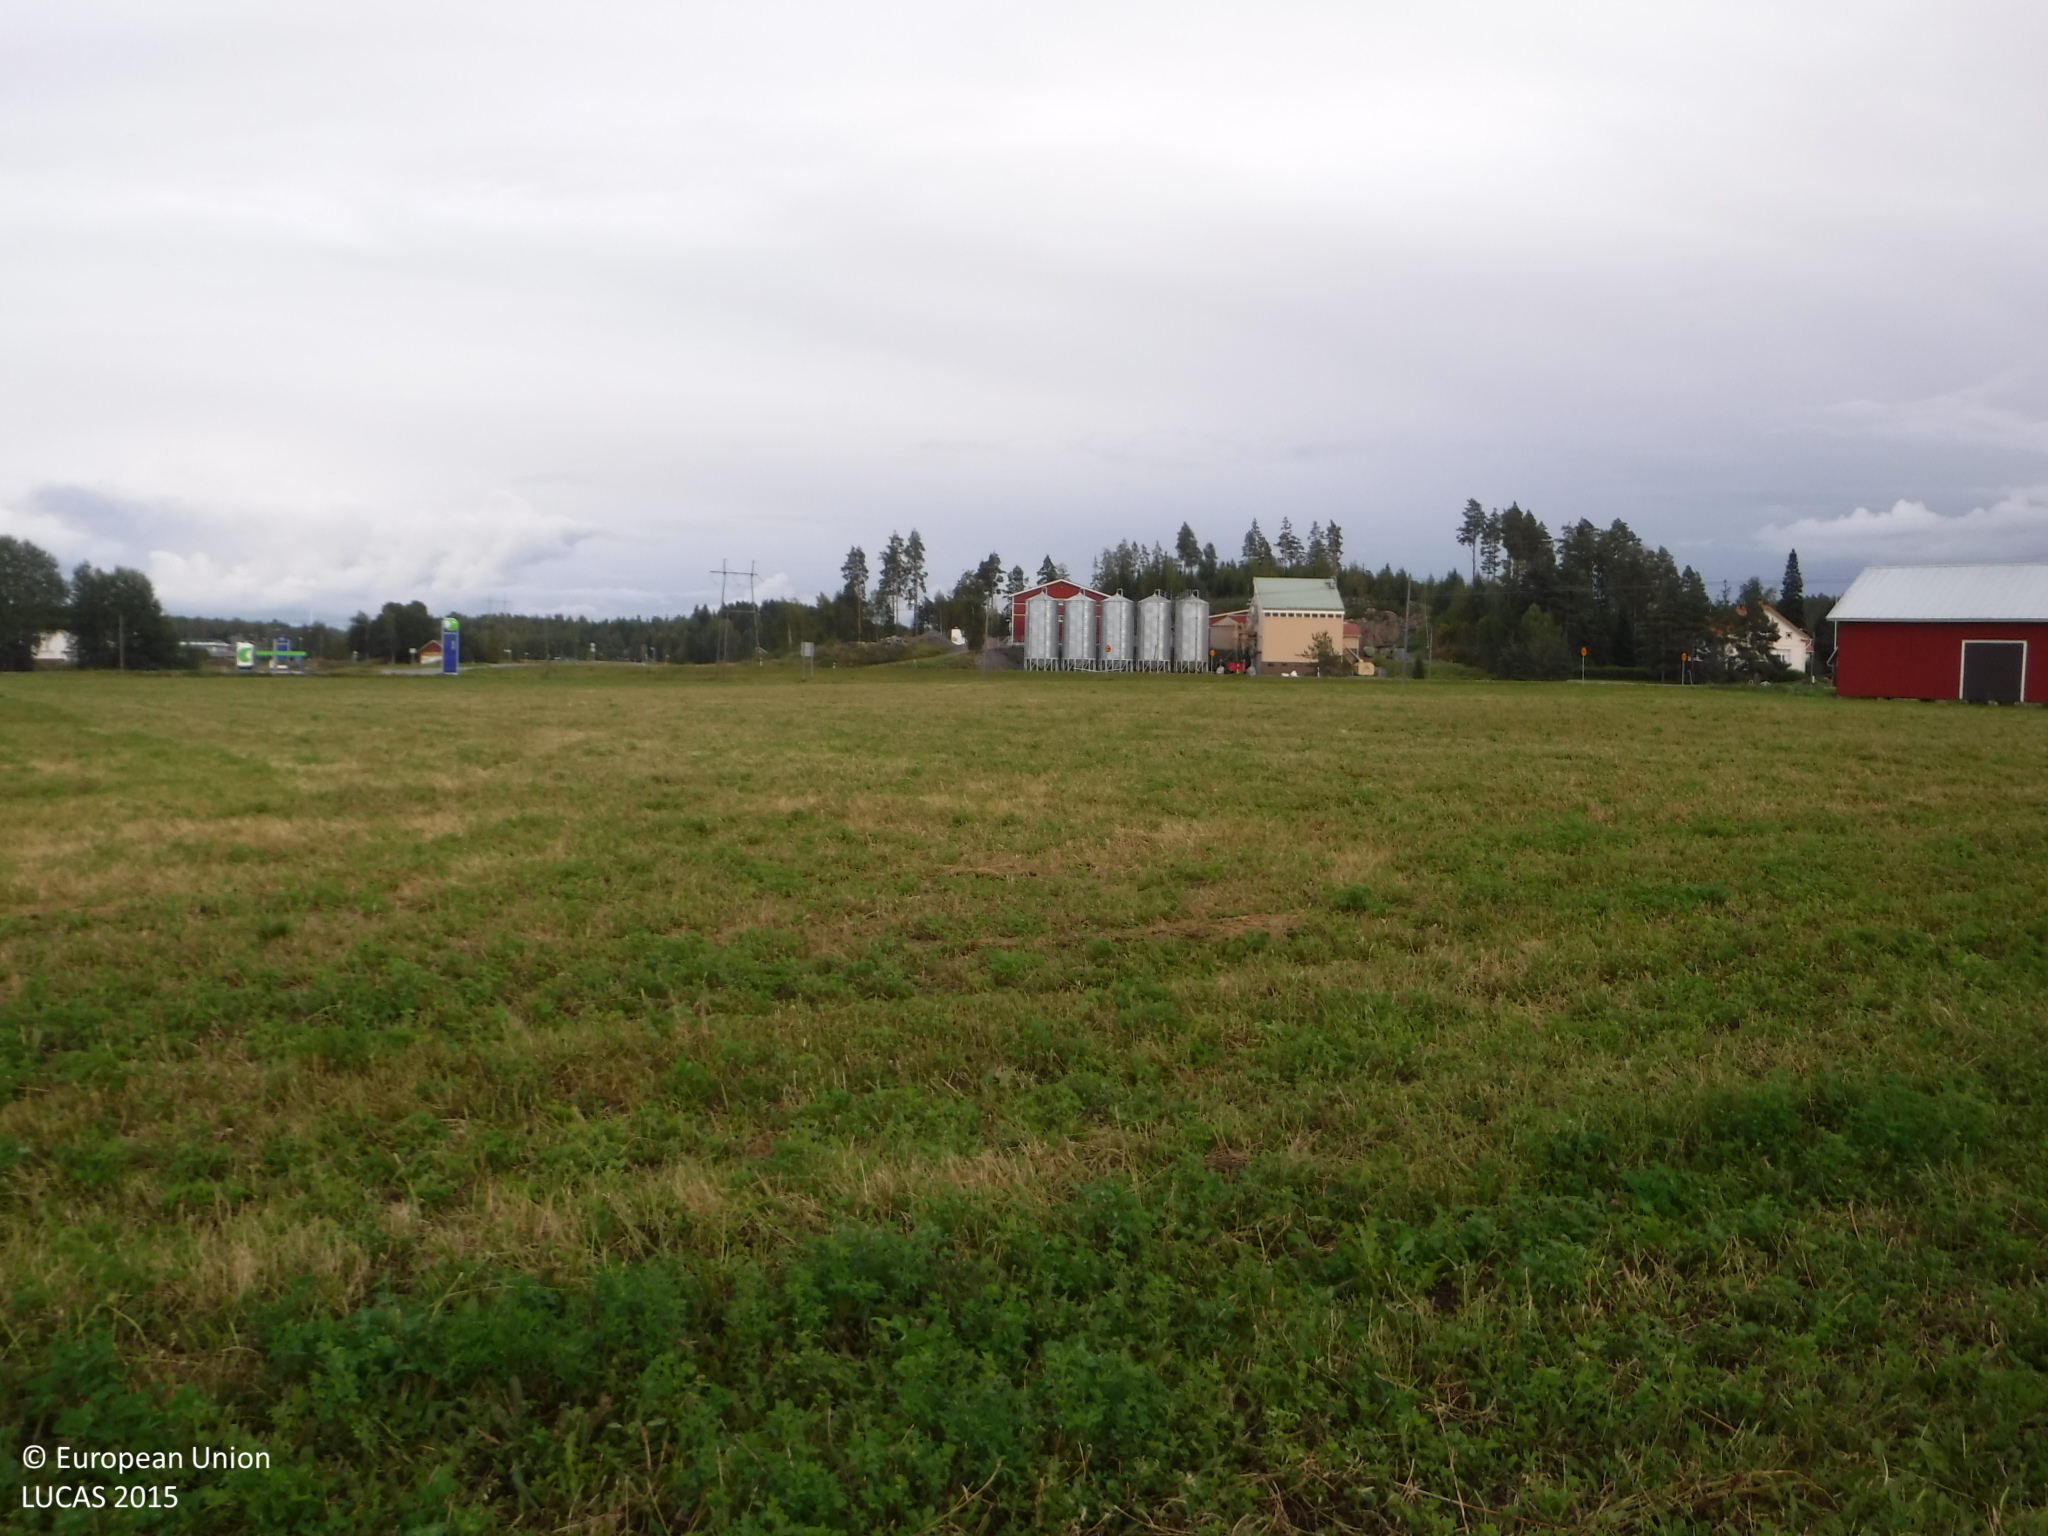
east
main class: Cropland
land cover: Oats
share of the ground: > 75 %
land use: Agriculture (excluding fallow land and kitchen gardens)
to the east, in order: Oats; Other leguminous and mixtures for fodder
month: September
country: FI
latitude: 61.3220
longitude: 22.9041
